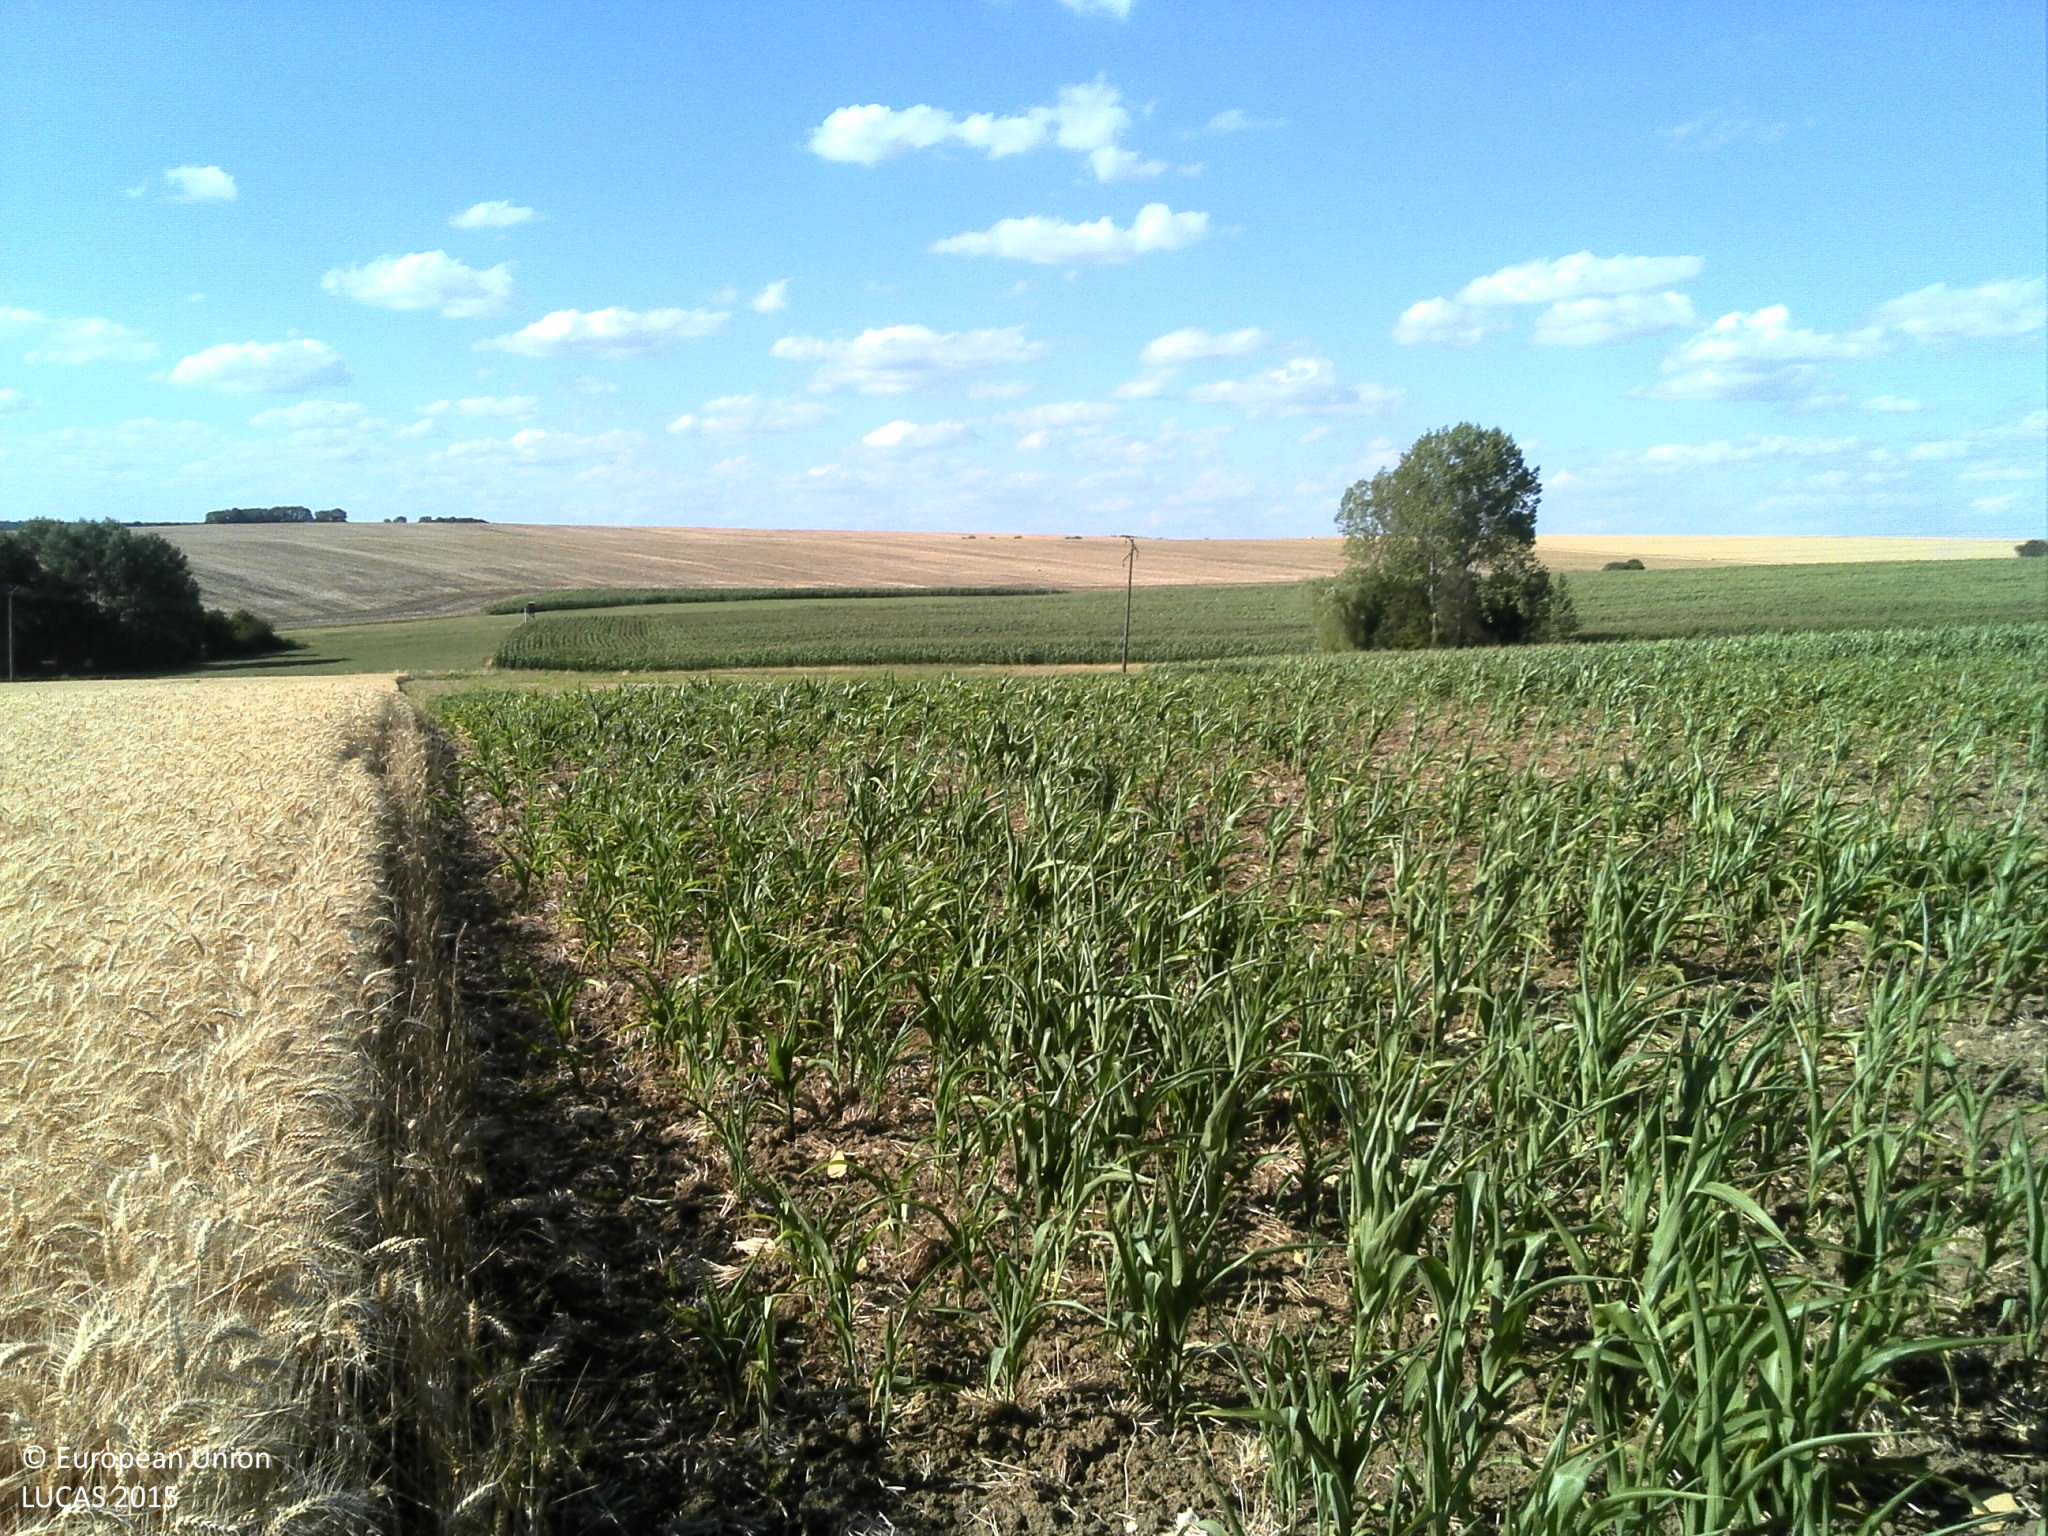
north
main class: Cropland
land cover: Common wheat
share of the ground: > 75 %
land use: Agriculture (excluding fallow land and kitchen gardens)
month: July
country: FR
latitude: 49.0713
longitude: 7.2491
